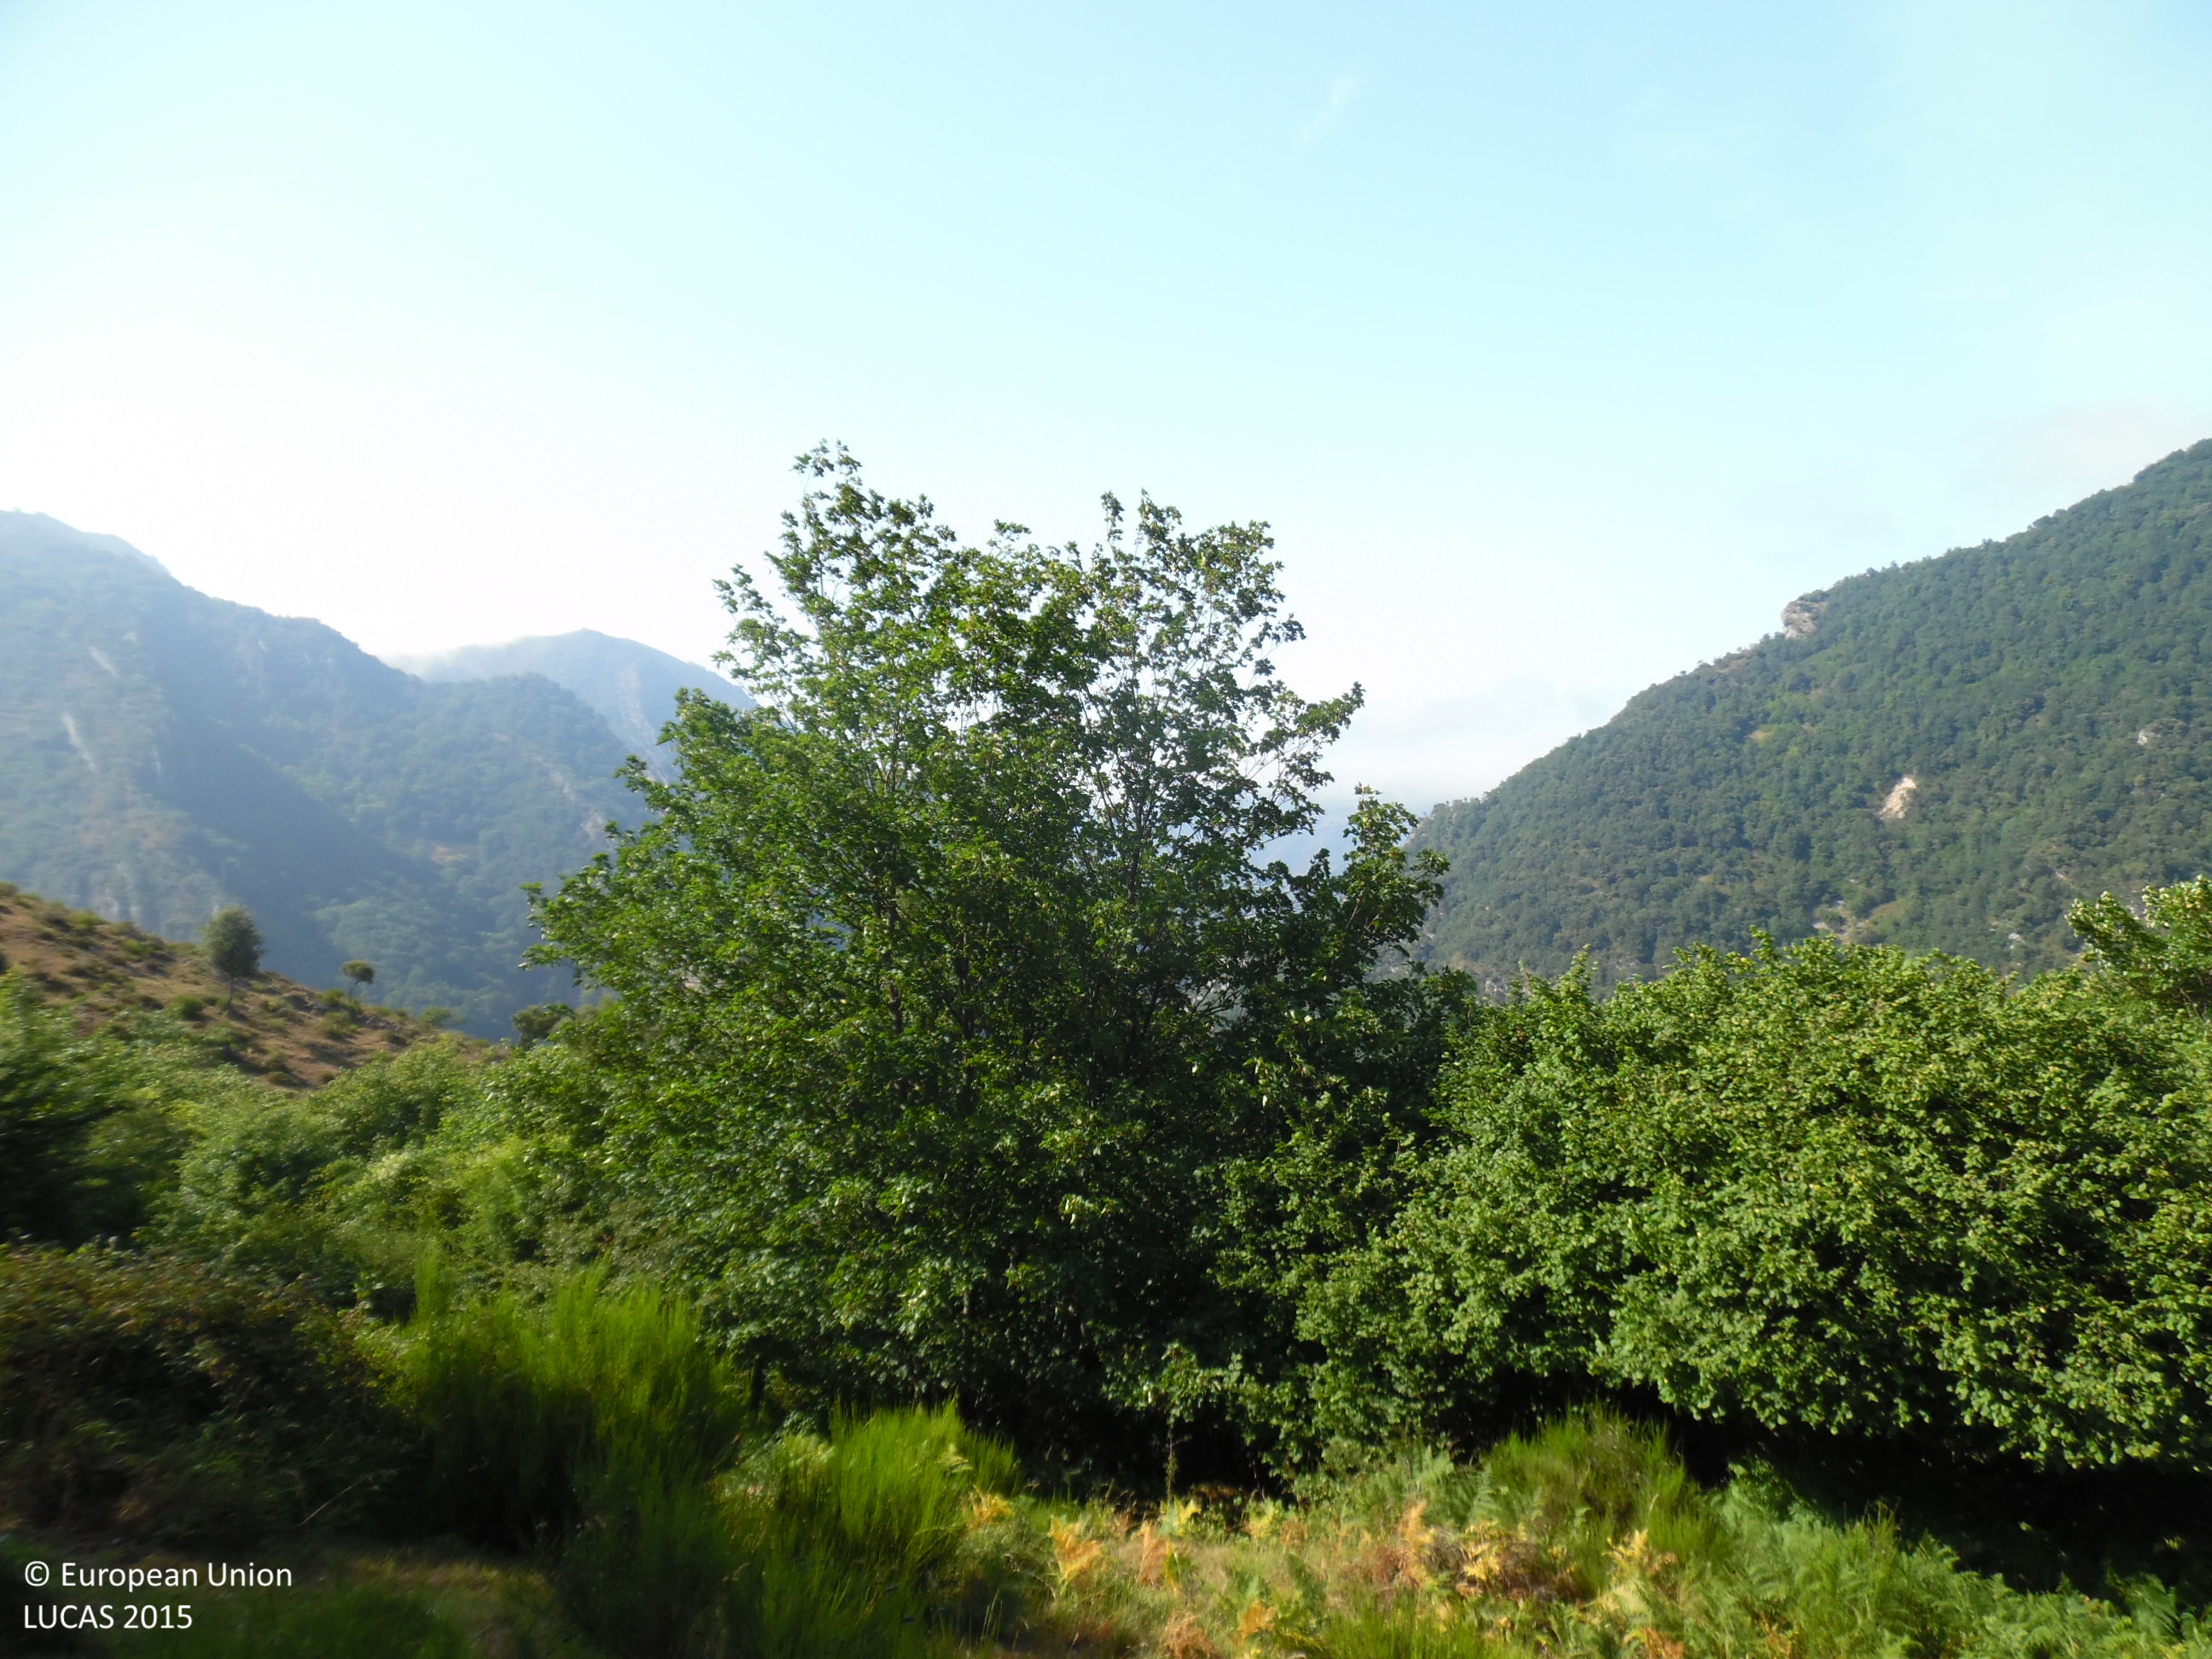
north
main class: Woodland
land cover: Broadleaved woodland
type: thermophilous deciduous forest
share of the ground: 25 - 50 %
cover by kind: herbaceous plants 50 %, broadleaved forest trees 30 %, shrubs 20 %
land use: Agriculture (excluding fallow land and kitchen gardens)
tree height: > 5 m
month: July
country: ES
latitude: 43.1312
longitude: -6.2597
